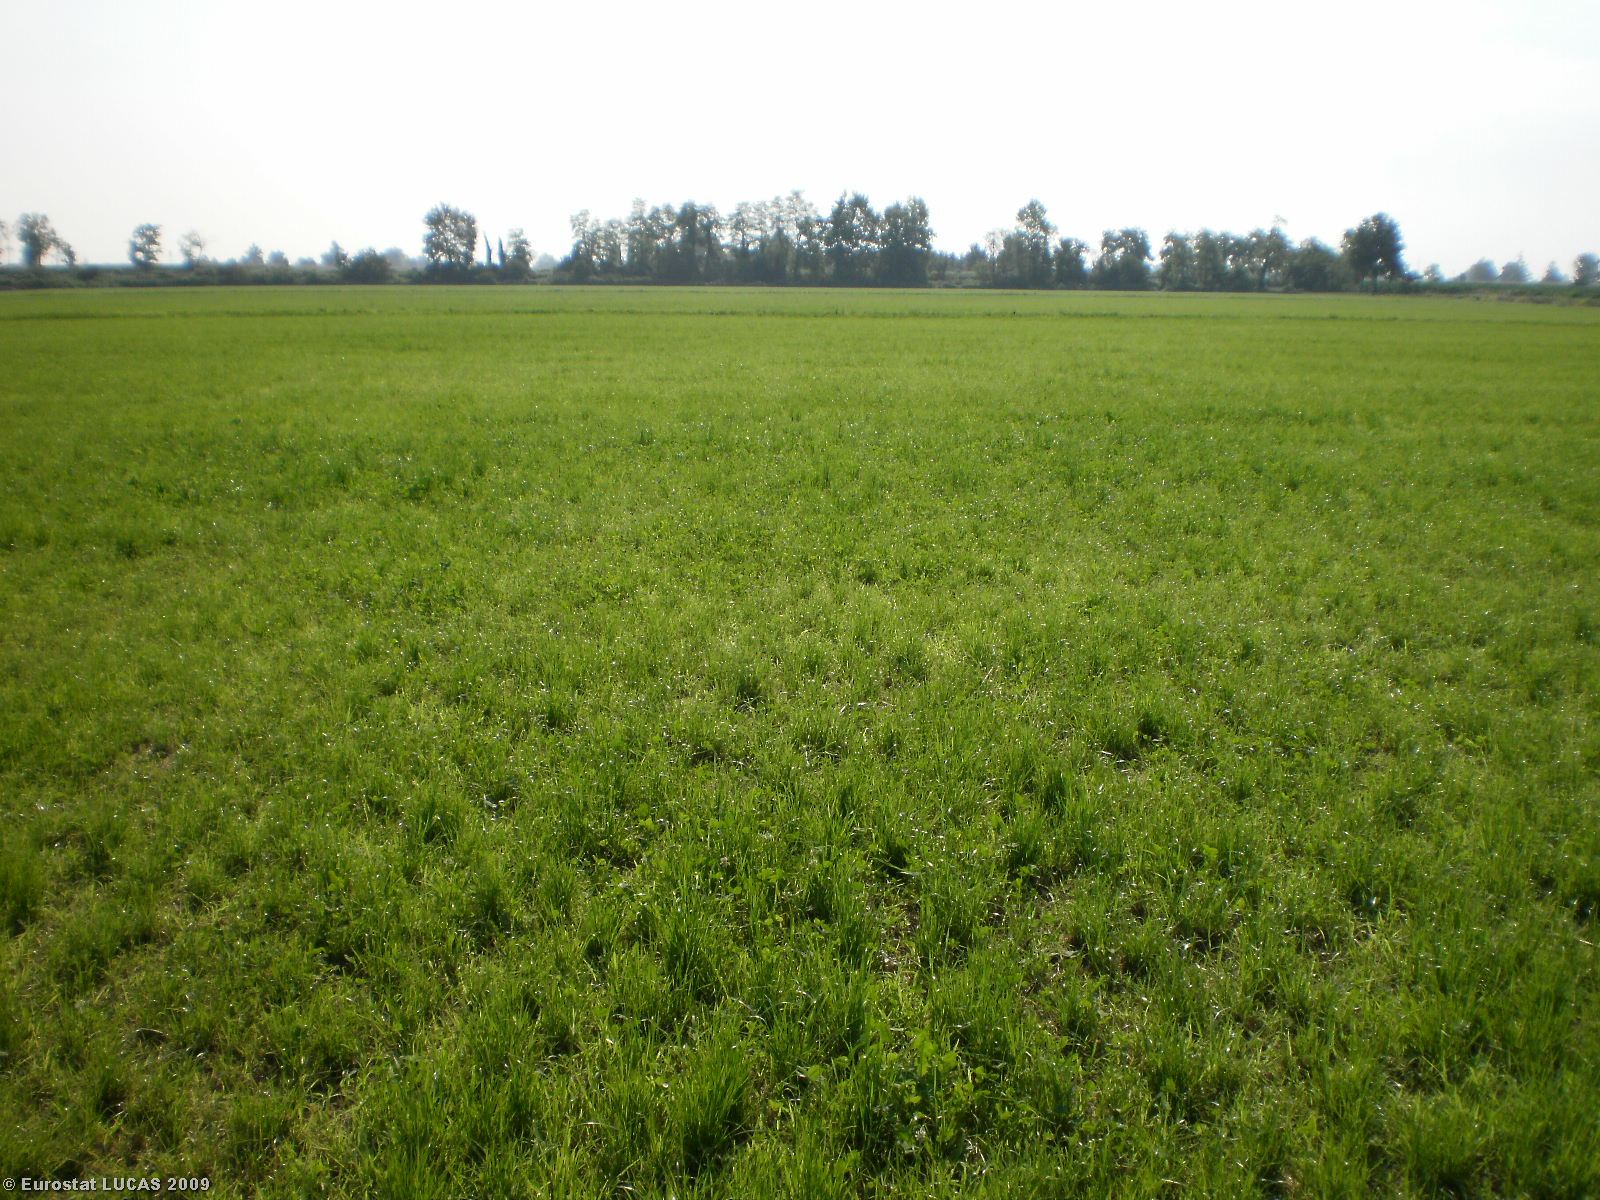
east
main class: Grassland
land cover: Grassland without tree/shrub cover
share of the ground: > 75 %
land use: Agriculture (excluding fallow land and kitchen gardens)
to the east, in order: Grassland without tree/shrub cover
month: July
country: IT
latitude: 45.4131
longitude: 9.5025
